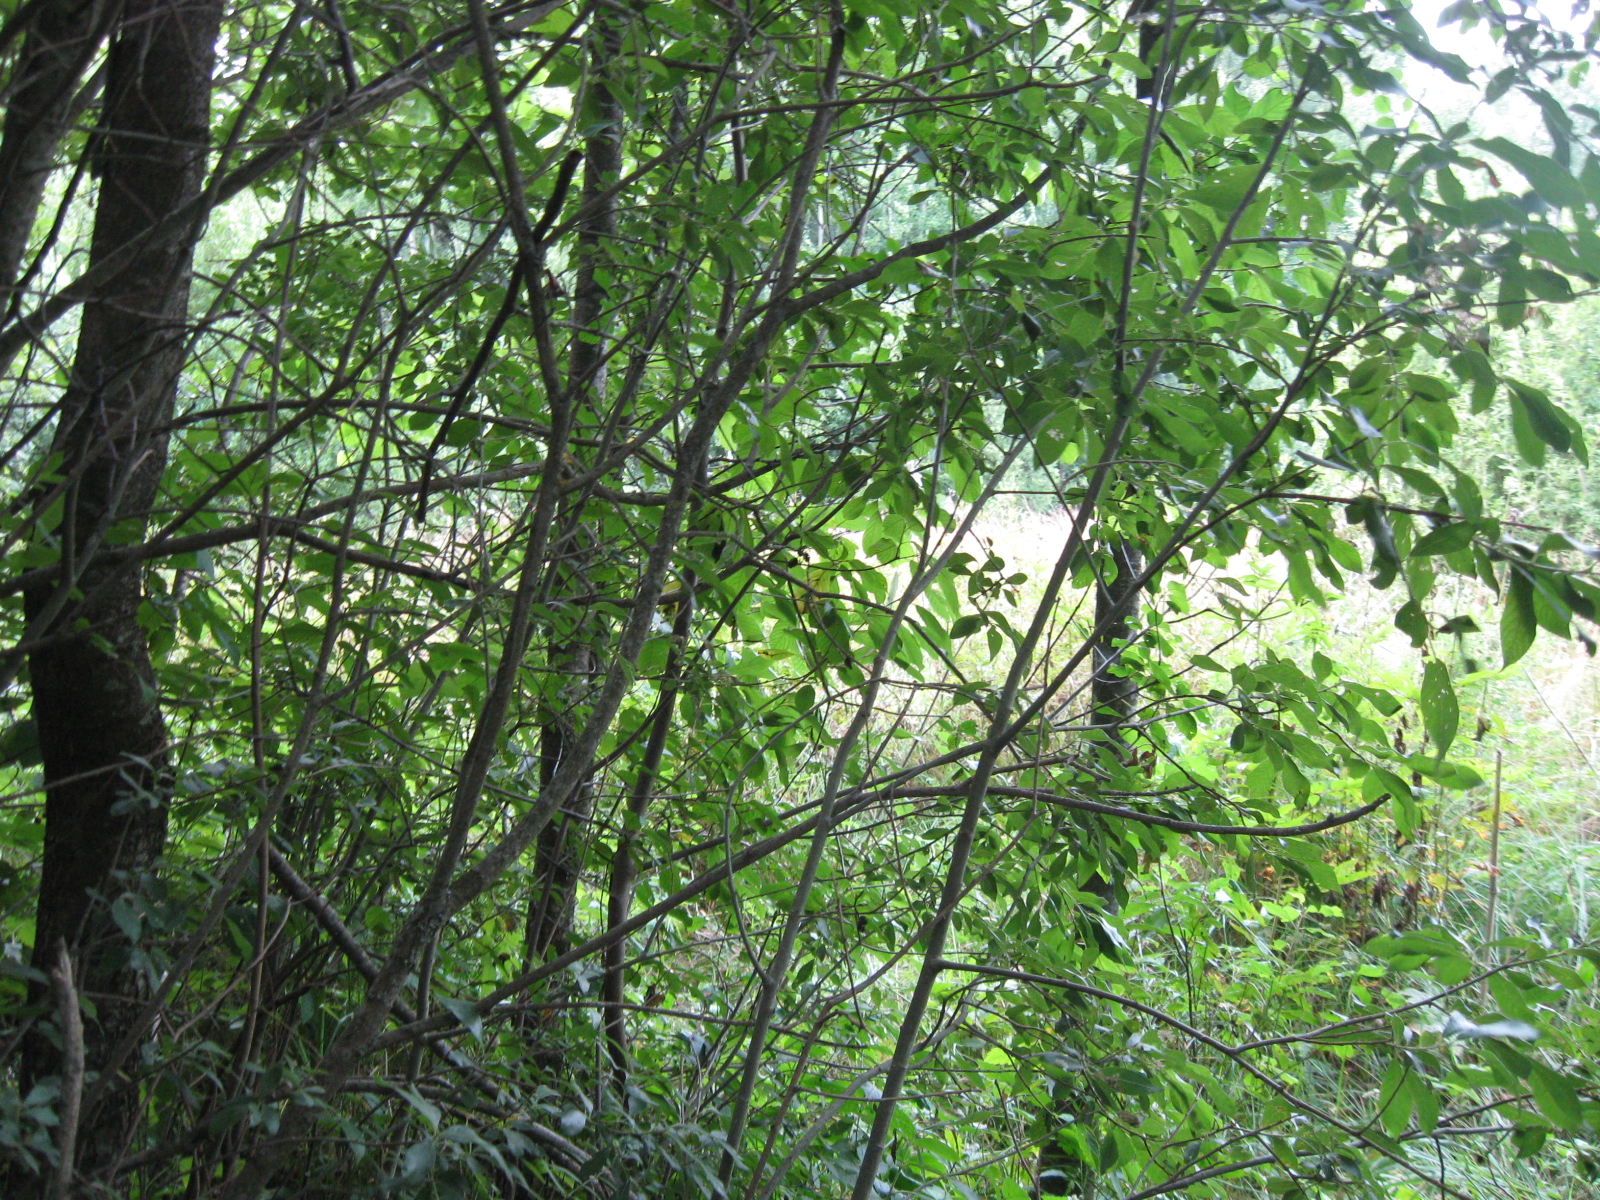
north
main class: Woodland
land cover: Broadleaved woodland
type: non-riverine alder, birch or aspen forest
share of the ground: > 75 %
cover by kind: broadleaved forest trees 80 %, herbaceous plants 15 %, coniferous forest trees 5 %
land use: Forestry
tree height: > 5 m
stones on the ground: < 10 %
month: July
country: LT
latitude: 54.6933
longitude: 23.7550
